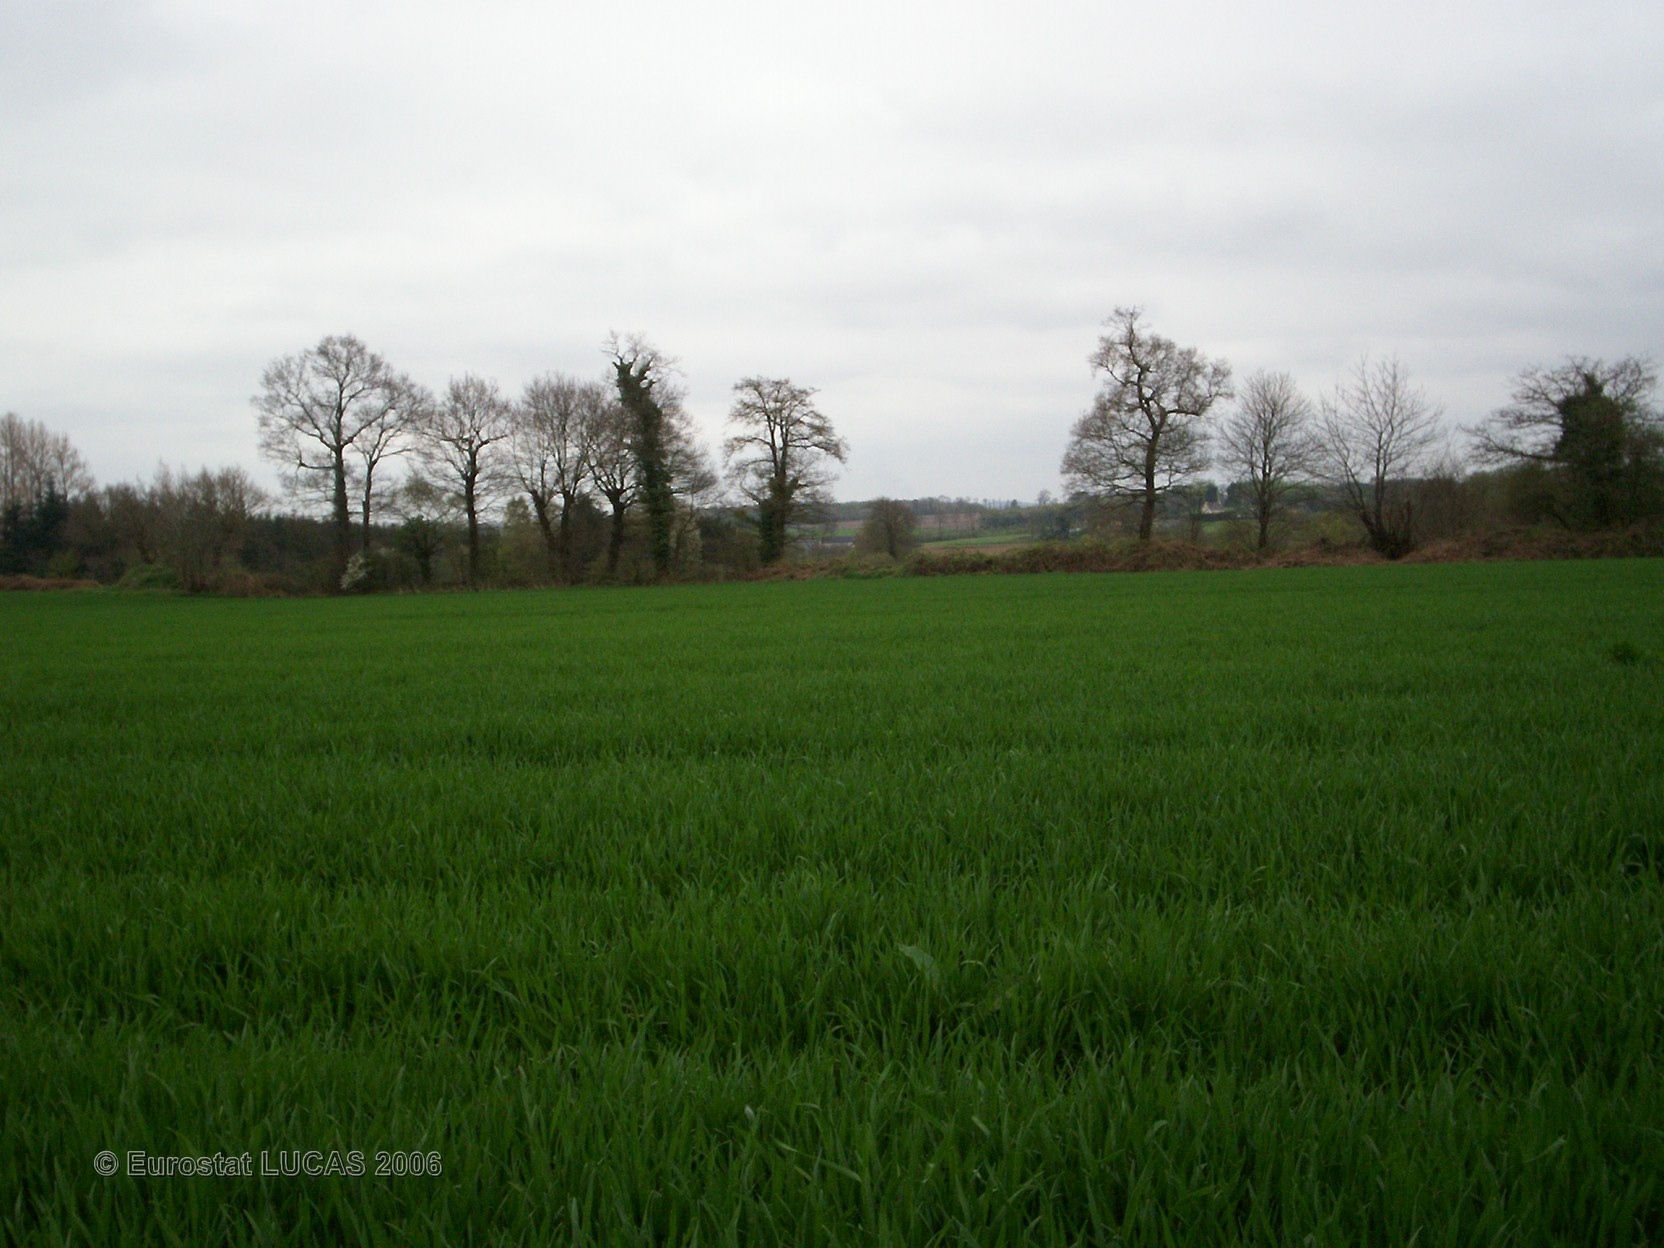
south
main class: Cropland
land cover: Common wheat
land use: Agriculture (excluding fallow land and kitchen gardens)
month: April
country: FR
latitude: 48.2414
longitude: -2.4617
